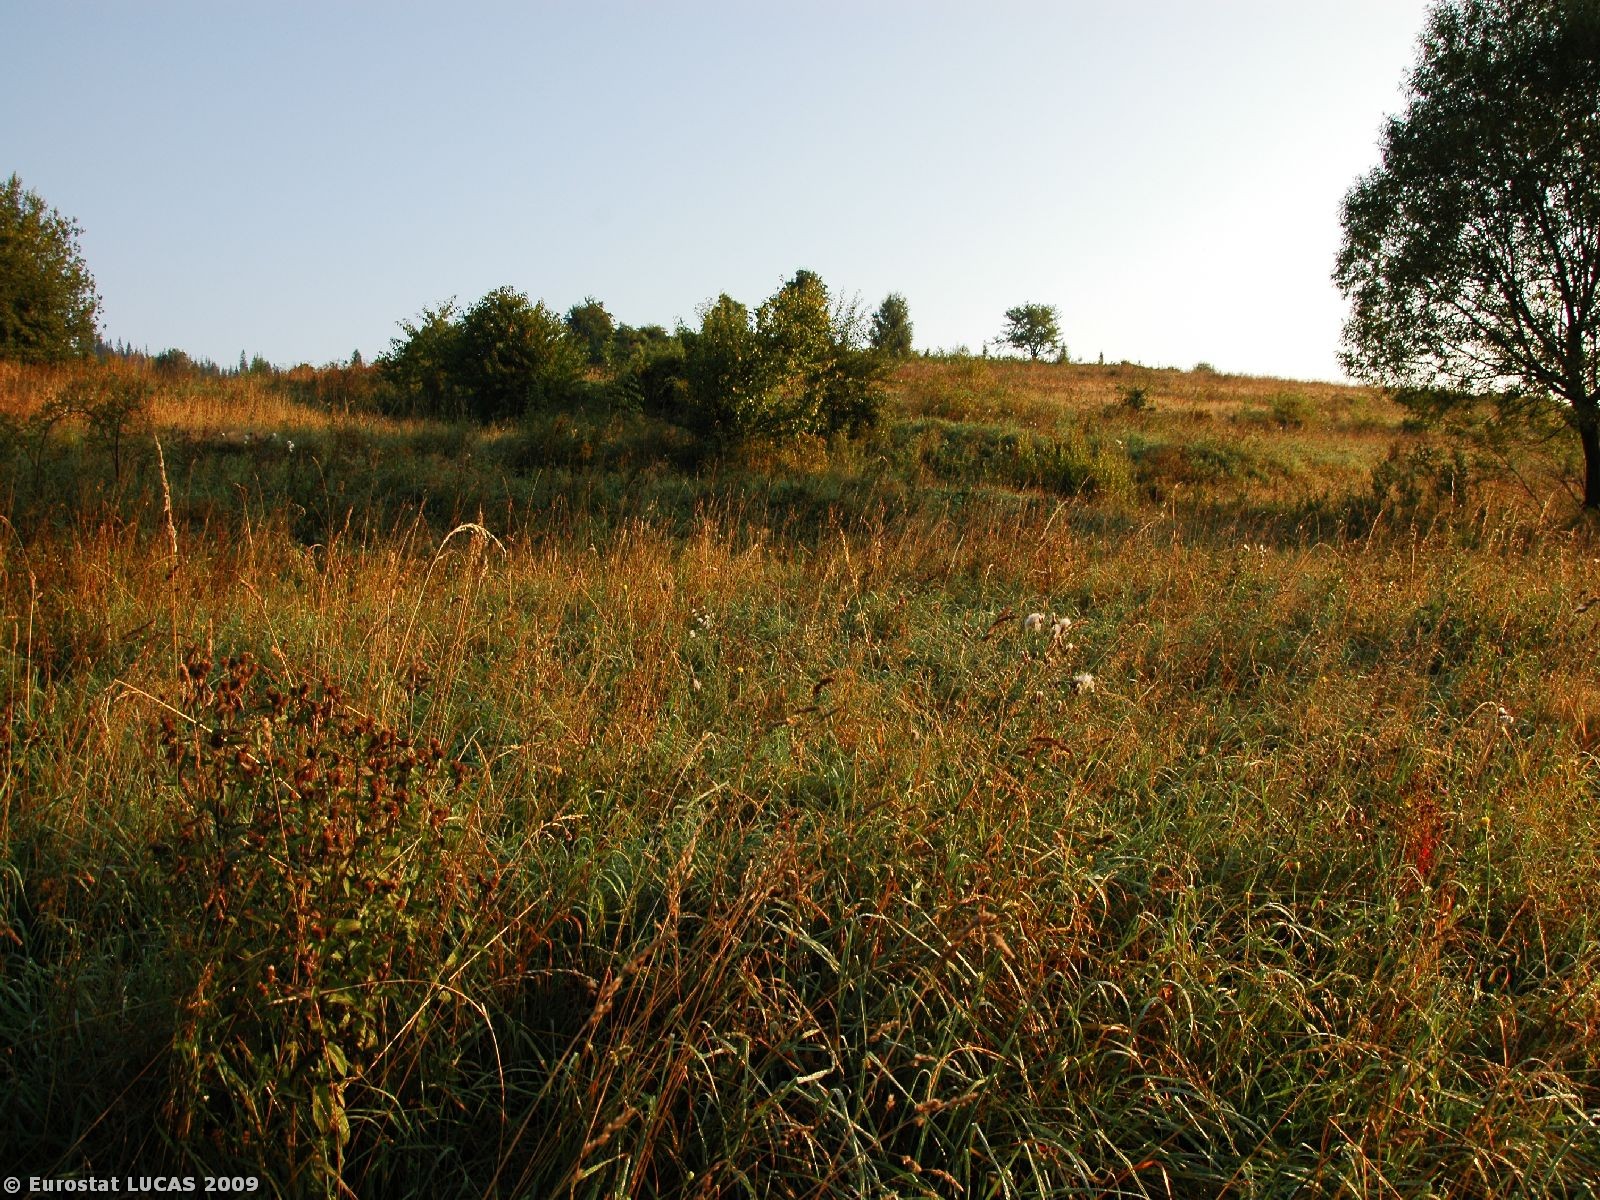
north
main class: Grassland
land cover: Grassland without tree/shrub cover
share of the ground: > 75 %
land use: Unused
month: August
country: PL
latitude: 49.5567
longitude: 18.9941
